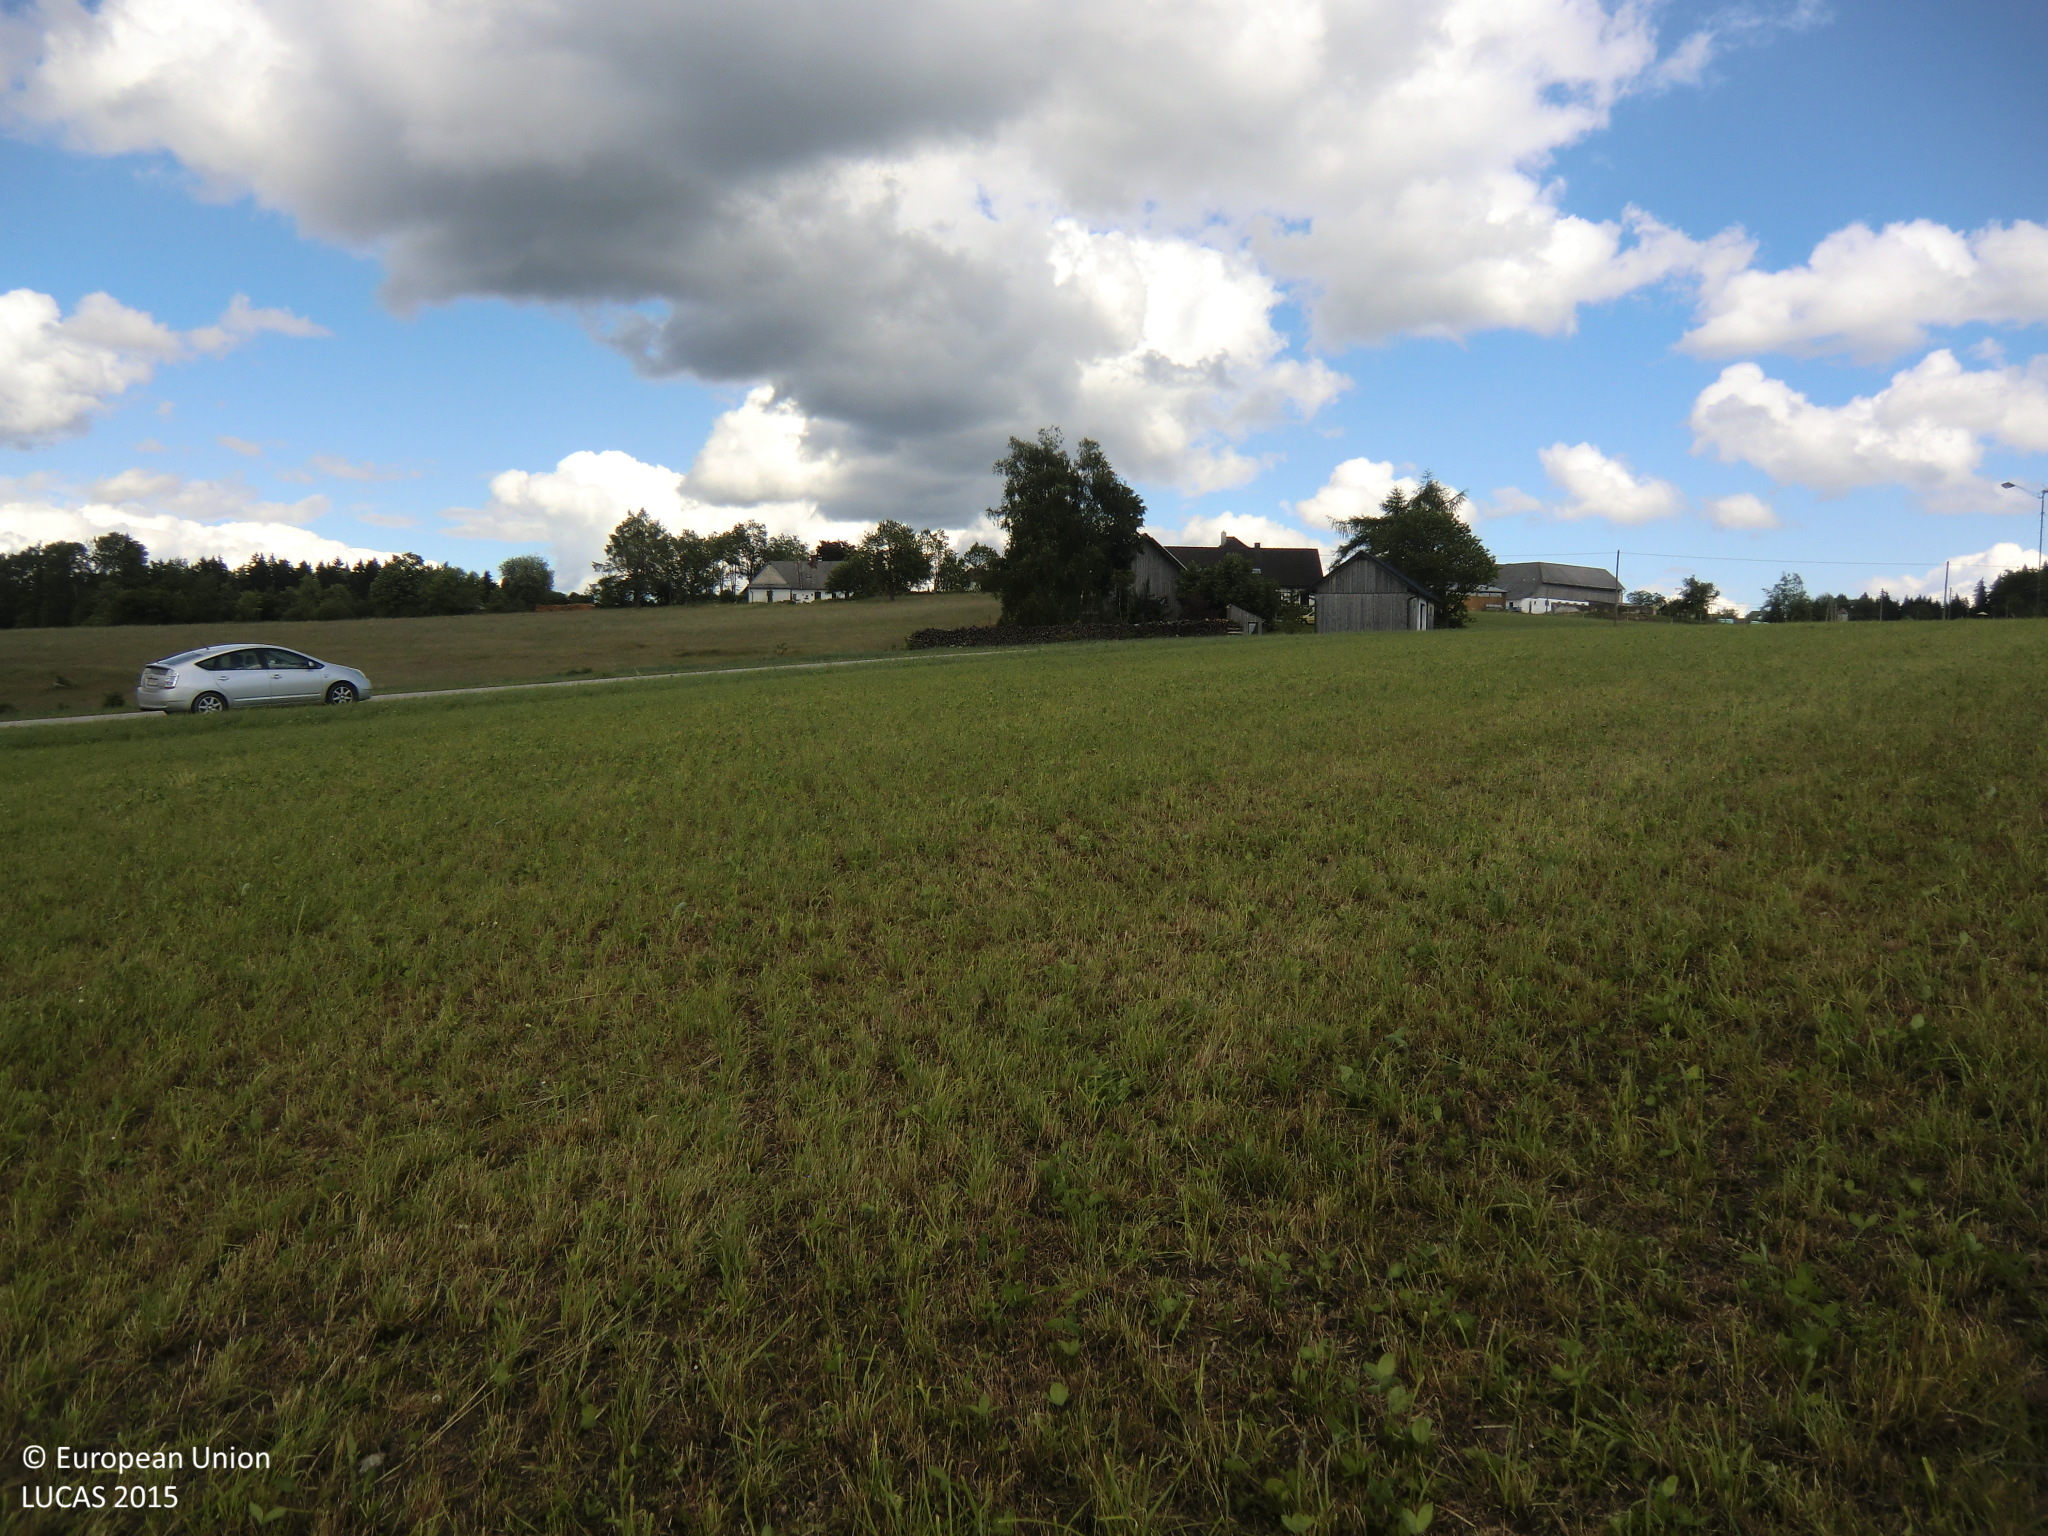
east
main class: Cropland
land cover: Temporary grasslands
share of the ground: 50 - 75 %
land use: Agriculture (excluding fallow land and kitchen gardens)
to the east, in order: Temporary grasslands; Paved roads, cycling and walking lanes; Grass margins; Common wheat; Artificial constructions in urban areas; Grassland without tree/shrub cover; Tracks; Cherry fruit; Grassland without tree/shrub cover; Paved roads, cycling and walking lanes; Grassland without tree/shrub cover; Broadleaved woodland; Grassland without tree/shrub cover
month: June
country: AT
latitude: 48.5367
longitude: 14.7278
